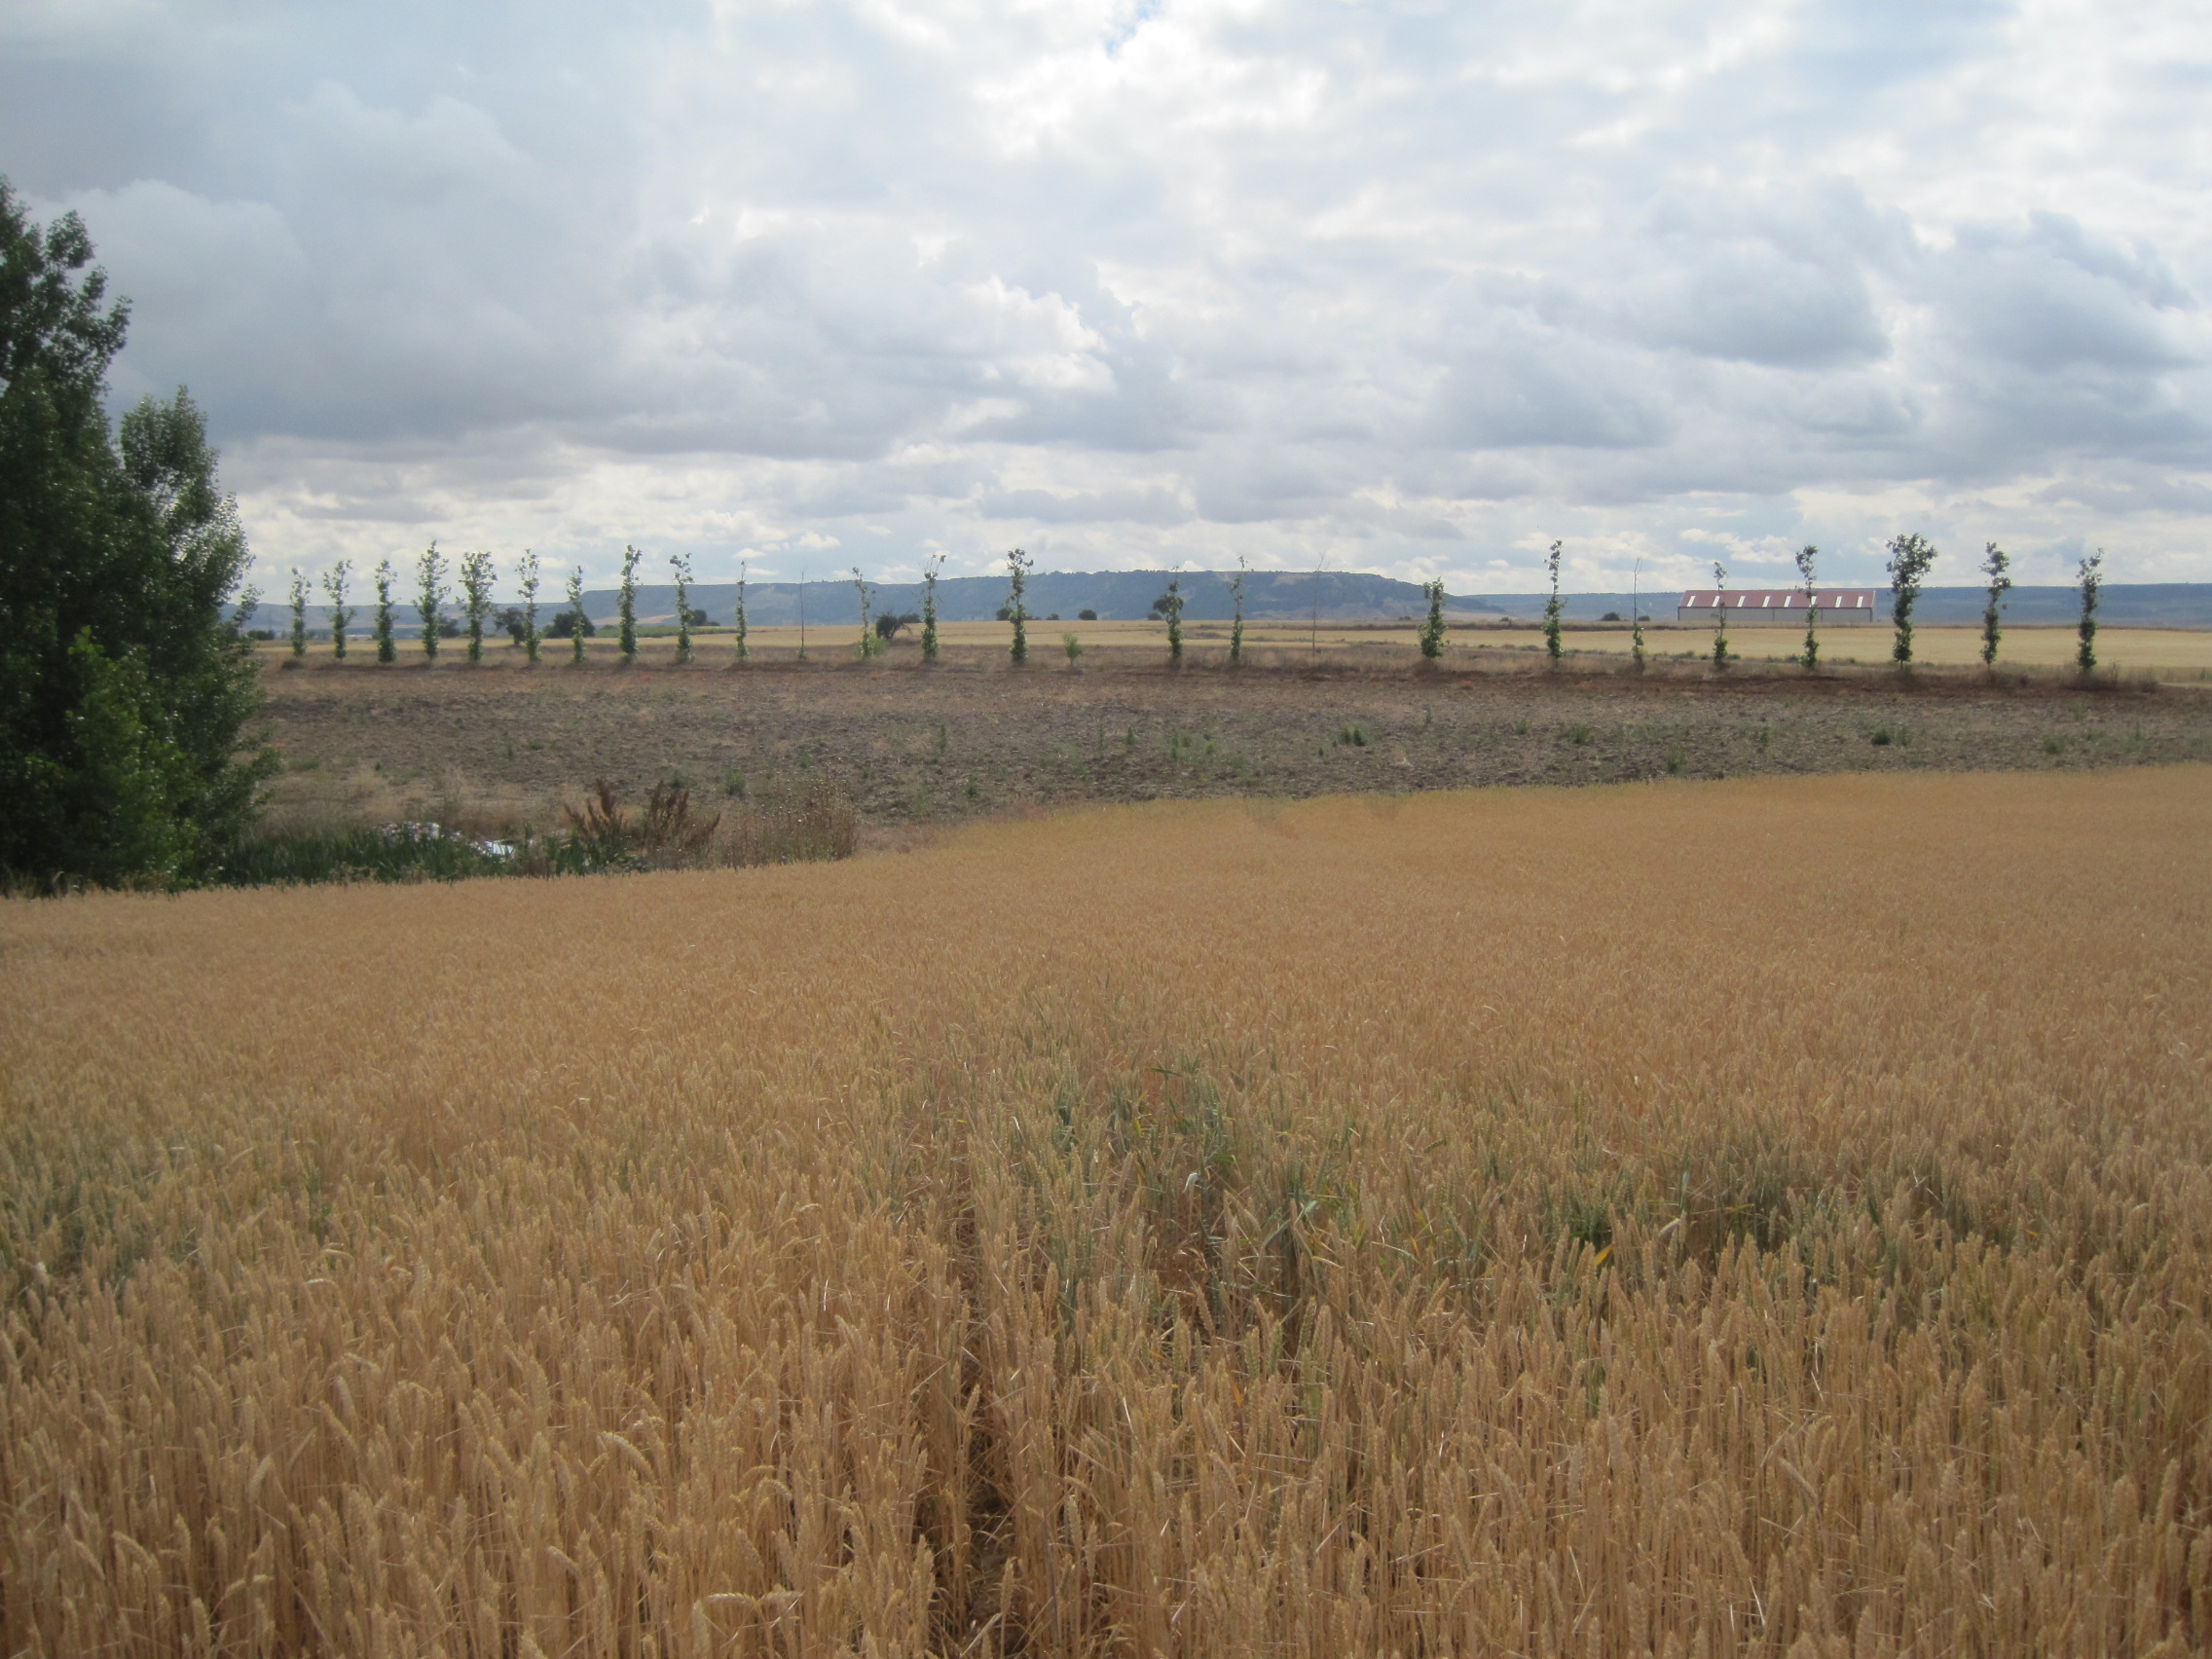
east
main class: Cropland
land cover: Common wheat
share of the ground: > 75 %
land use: Agriculture (excluding fallow land and kitchen gardens)
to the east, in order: Common wheat; Other bare soil; Lines of trees; Grass margins; Other bare soil
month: June
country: ES
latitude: 41.7393
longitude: -4.7028
